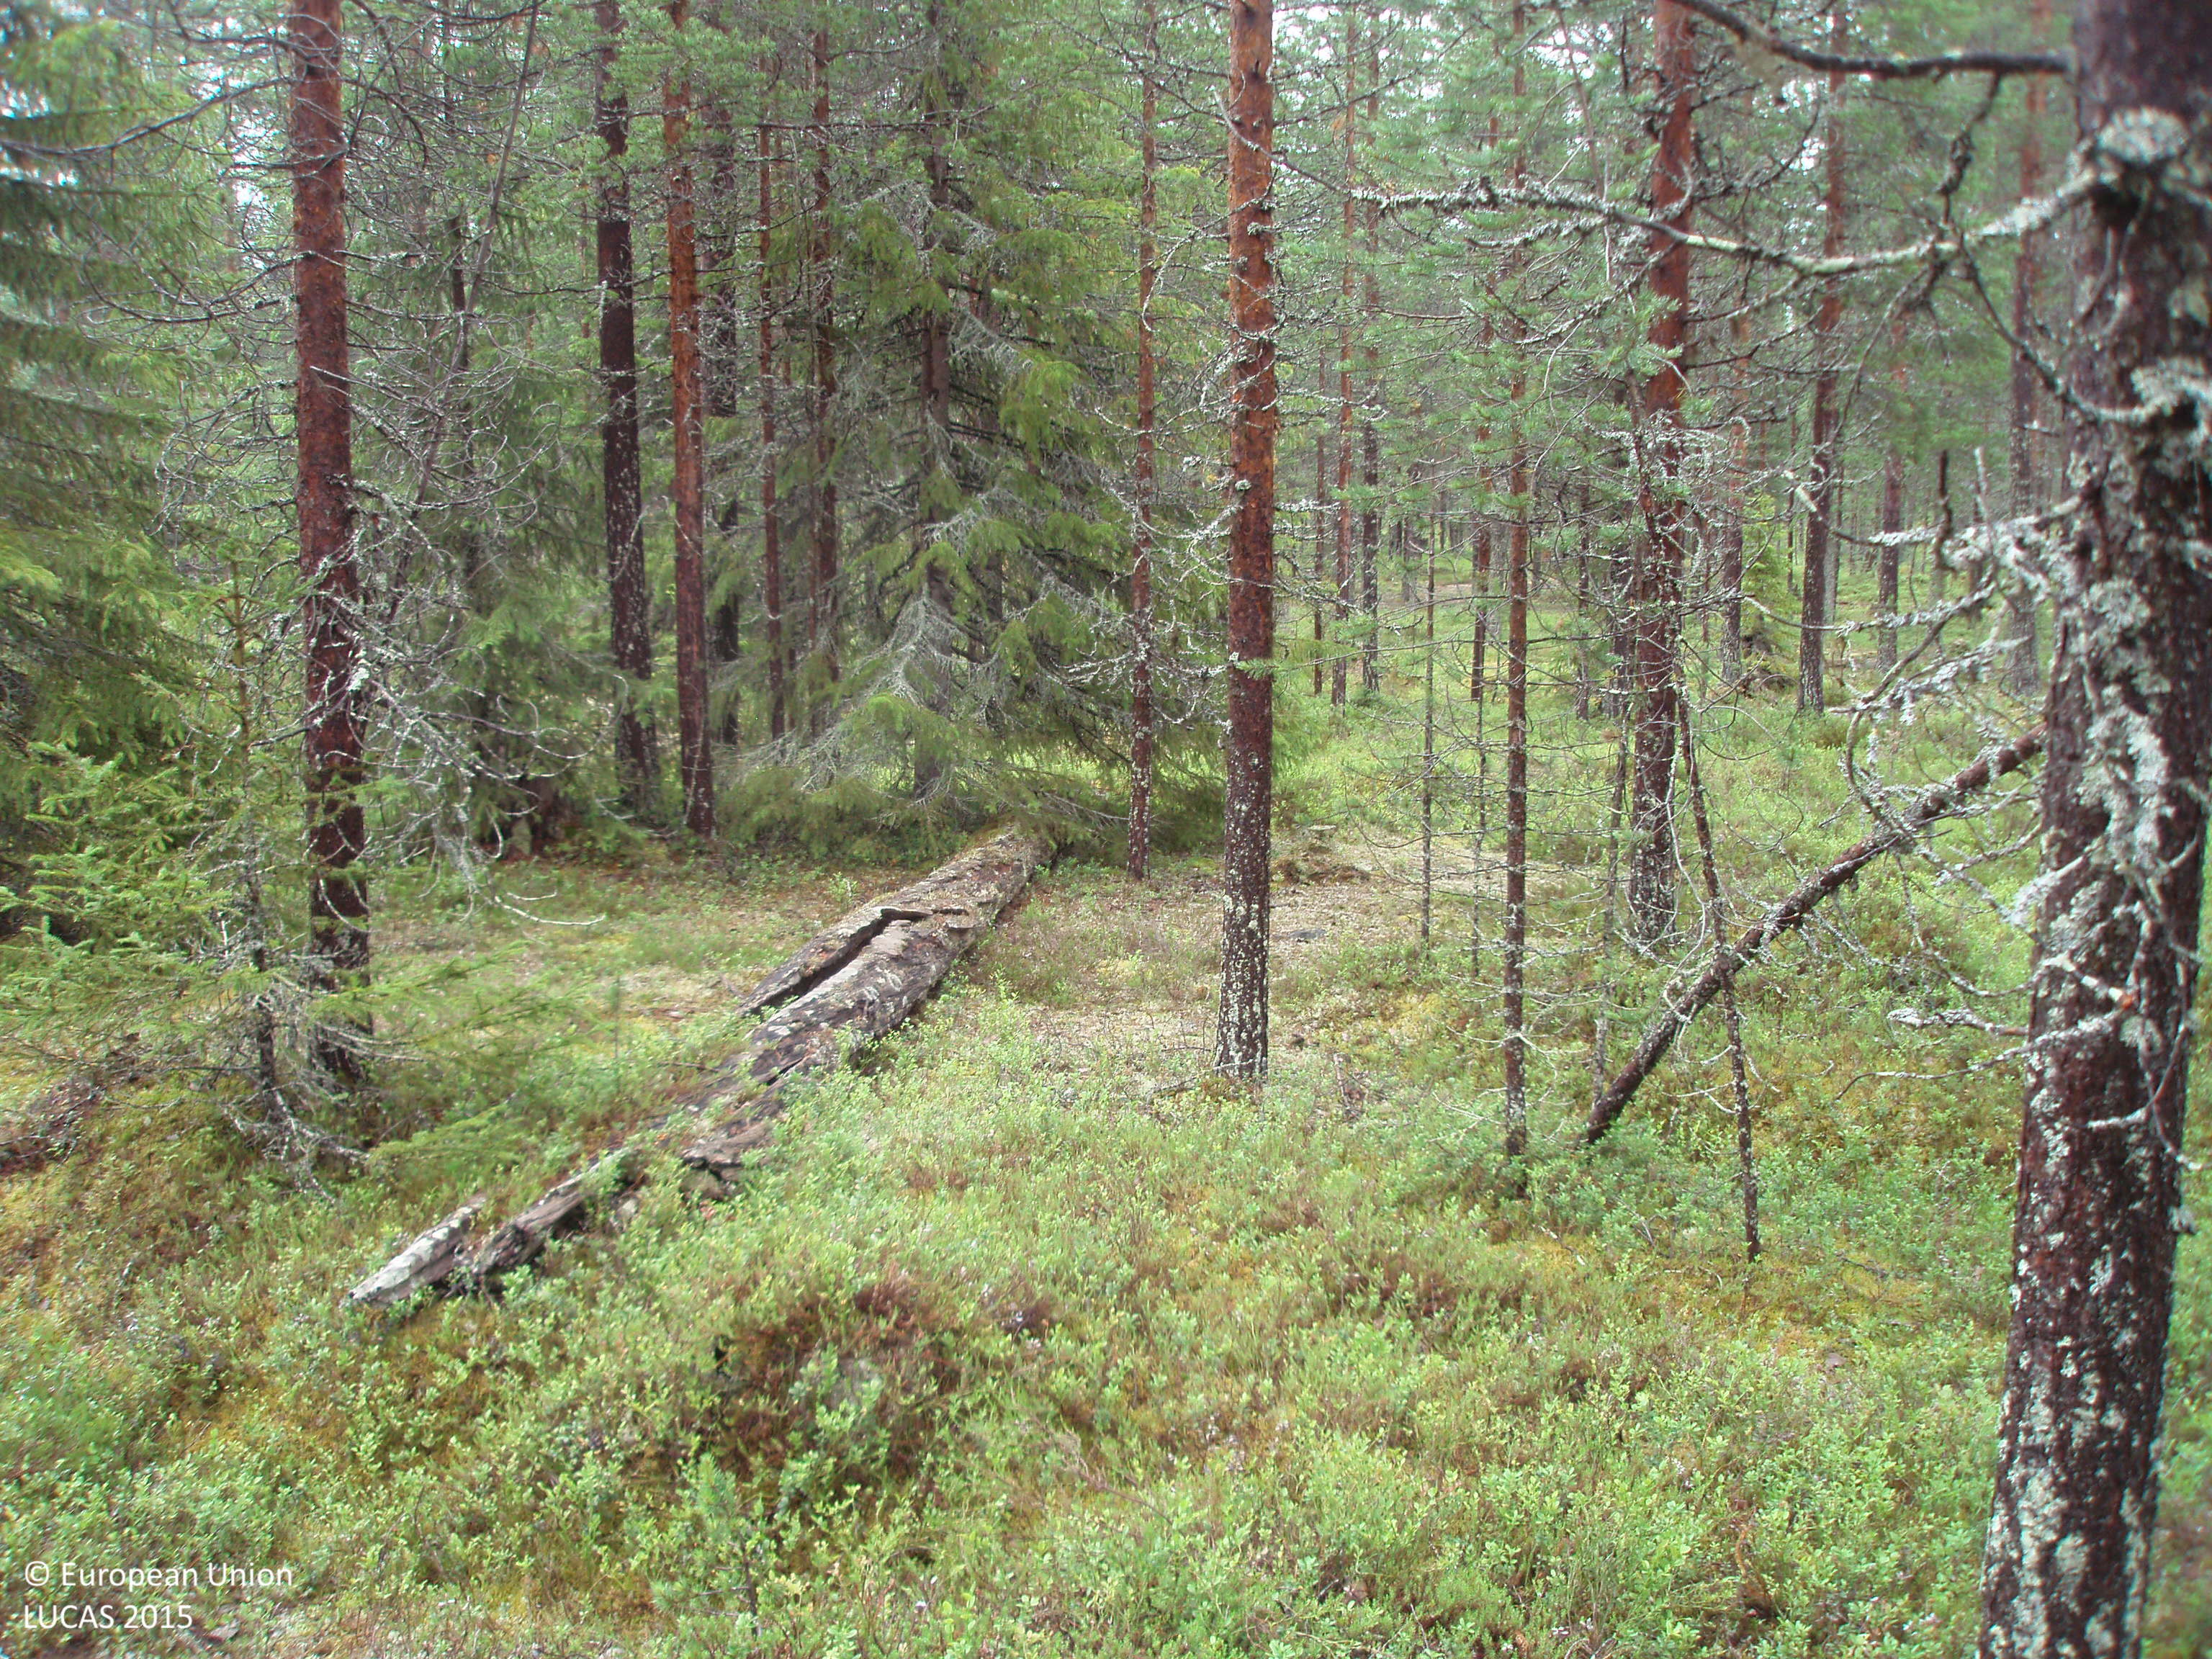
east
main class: Woodland
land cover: Pine dominated coniferous woodland
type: boreal forest
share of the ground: 50 - 75 %
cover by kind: coniferous forest trees 70 %, shrubs 30 %
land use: Forestry
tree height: > 5 m
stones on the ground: 25 - 50 %
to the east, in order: Pine dominated coniferous woodland
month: July
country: FI
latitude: 66.0339
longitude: 28.0762
